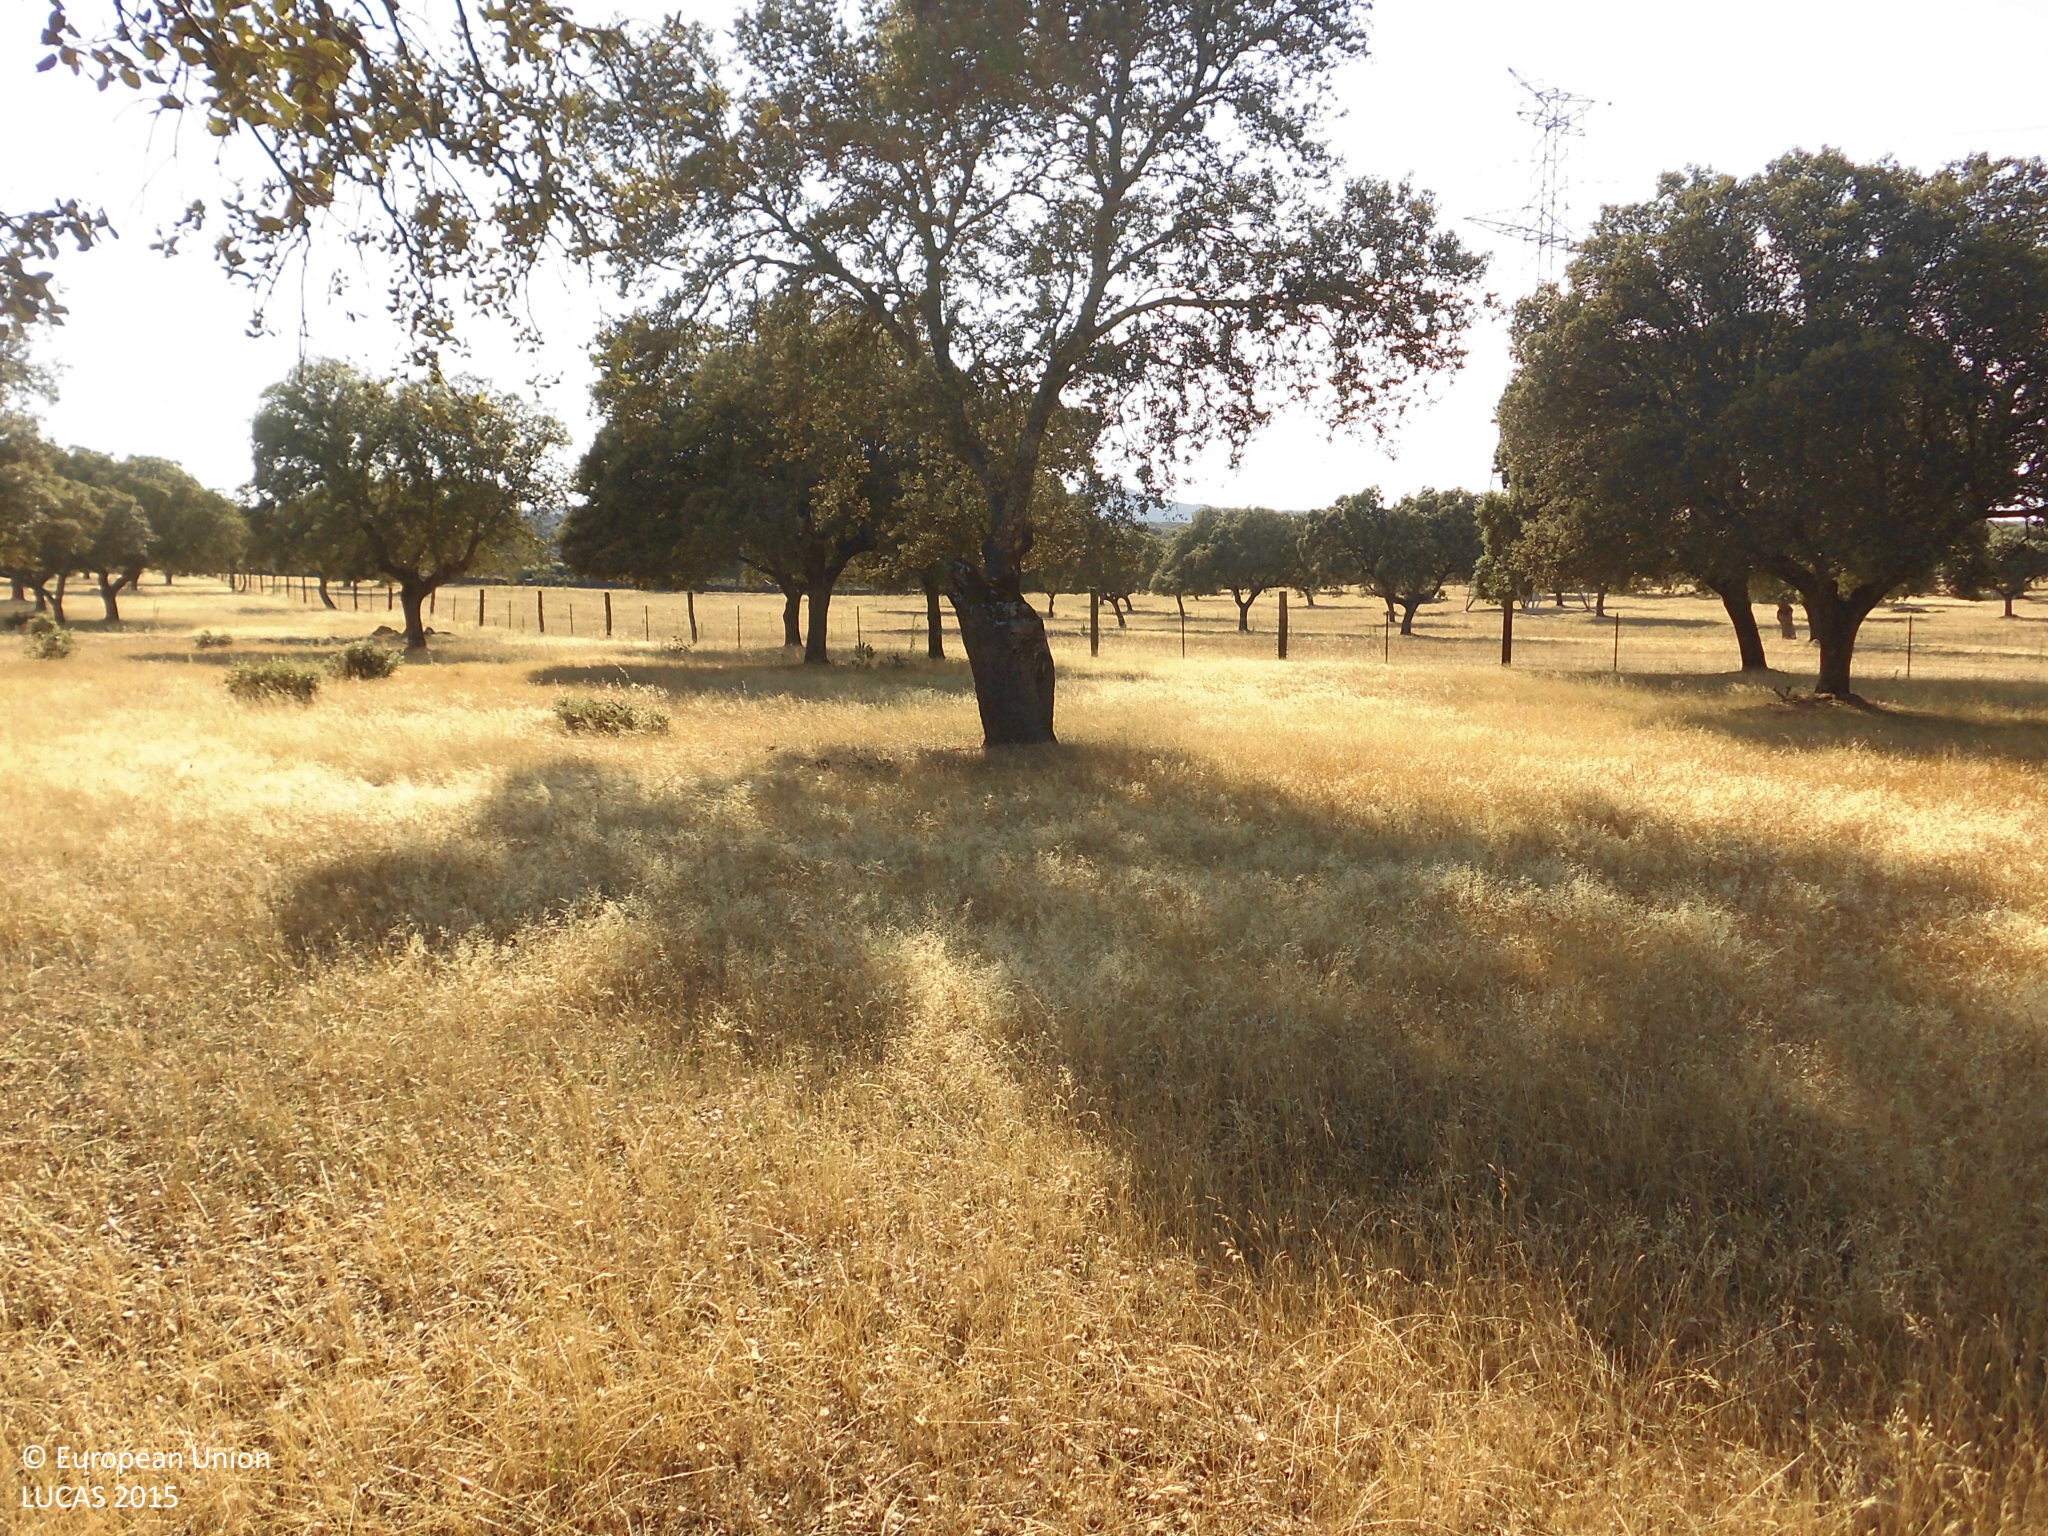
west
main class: Woodland
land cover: Broadleaved woodland
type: broadleaved evergreen forest
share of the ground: 25 - 50 %
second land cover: Grassland without tree/shrub cover
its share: > 75 %
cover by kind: broadleaved forest trees 50 %, herbaceous plants 50 %
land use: Forestry
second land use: Agriculture (excluding fallow land and kitchen gardens)
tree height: > 5 m
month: June
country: ES
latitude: 39.9376
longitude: -6.1148
